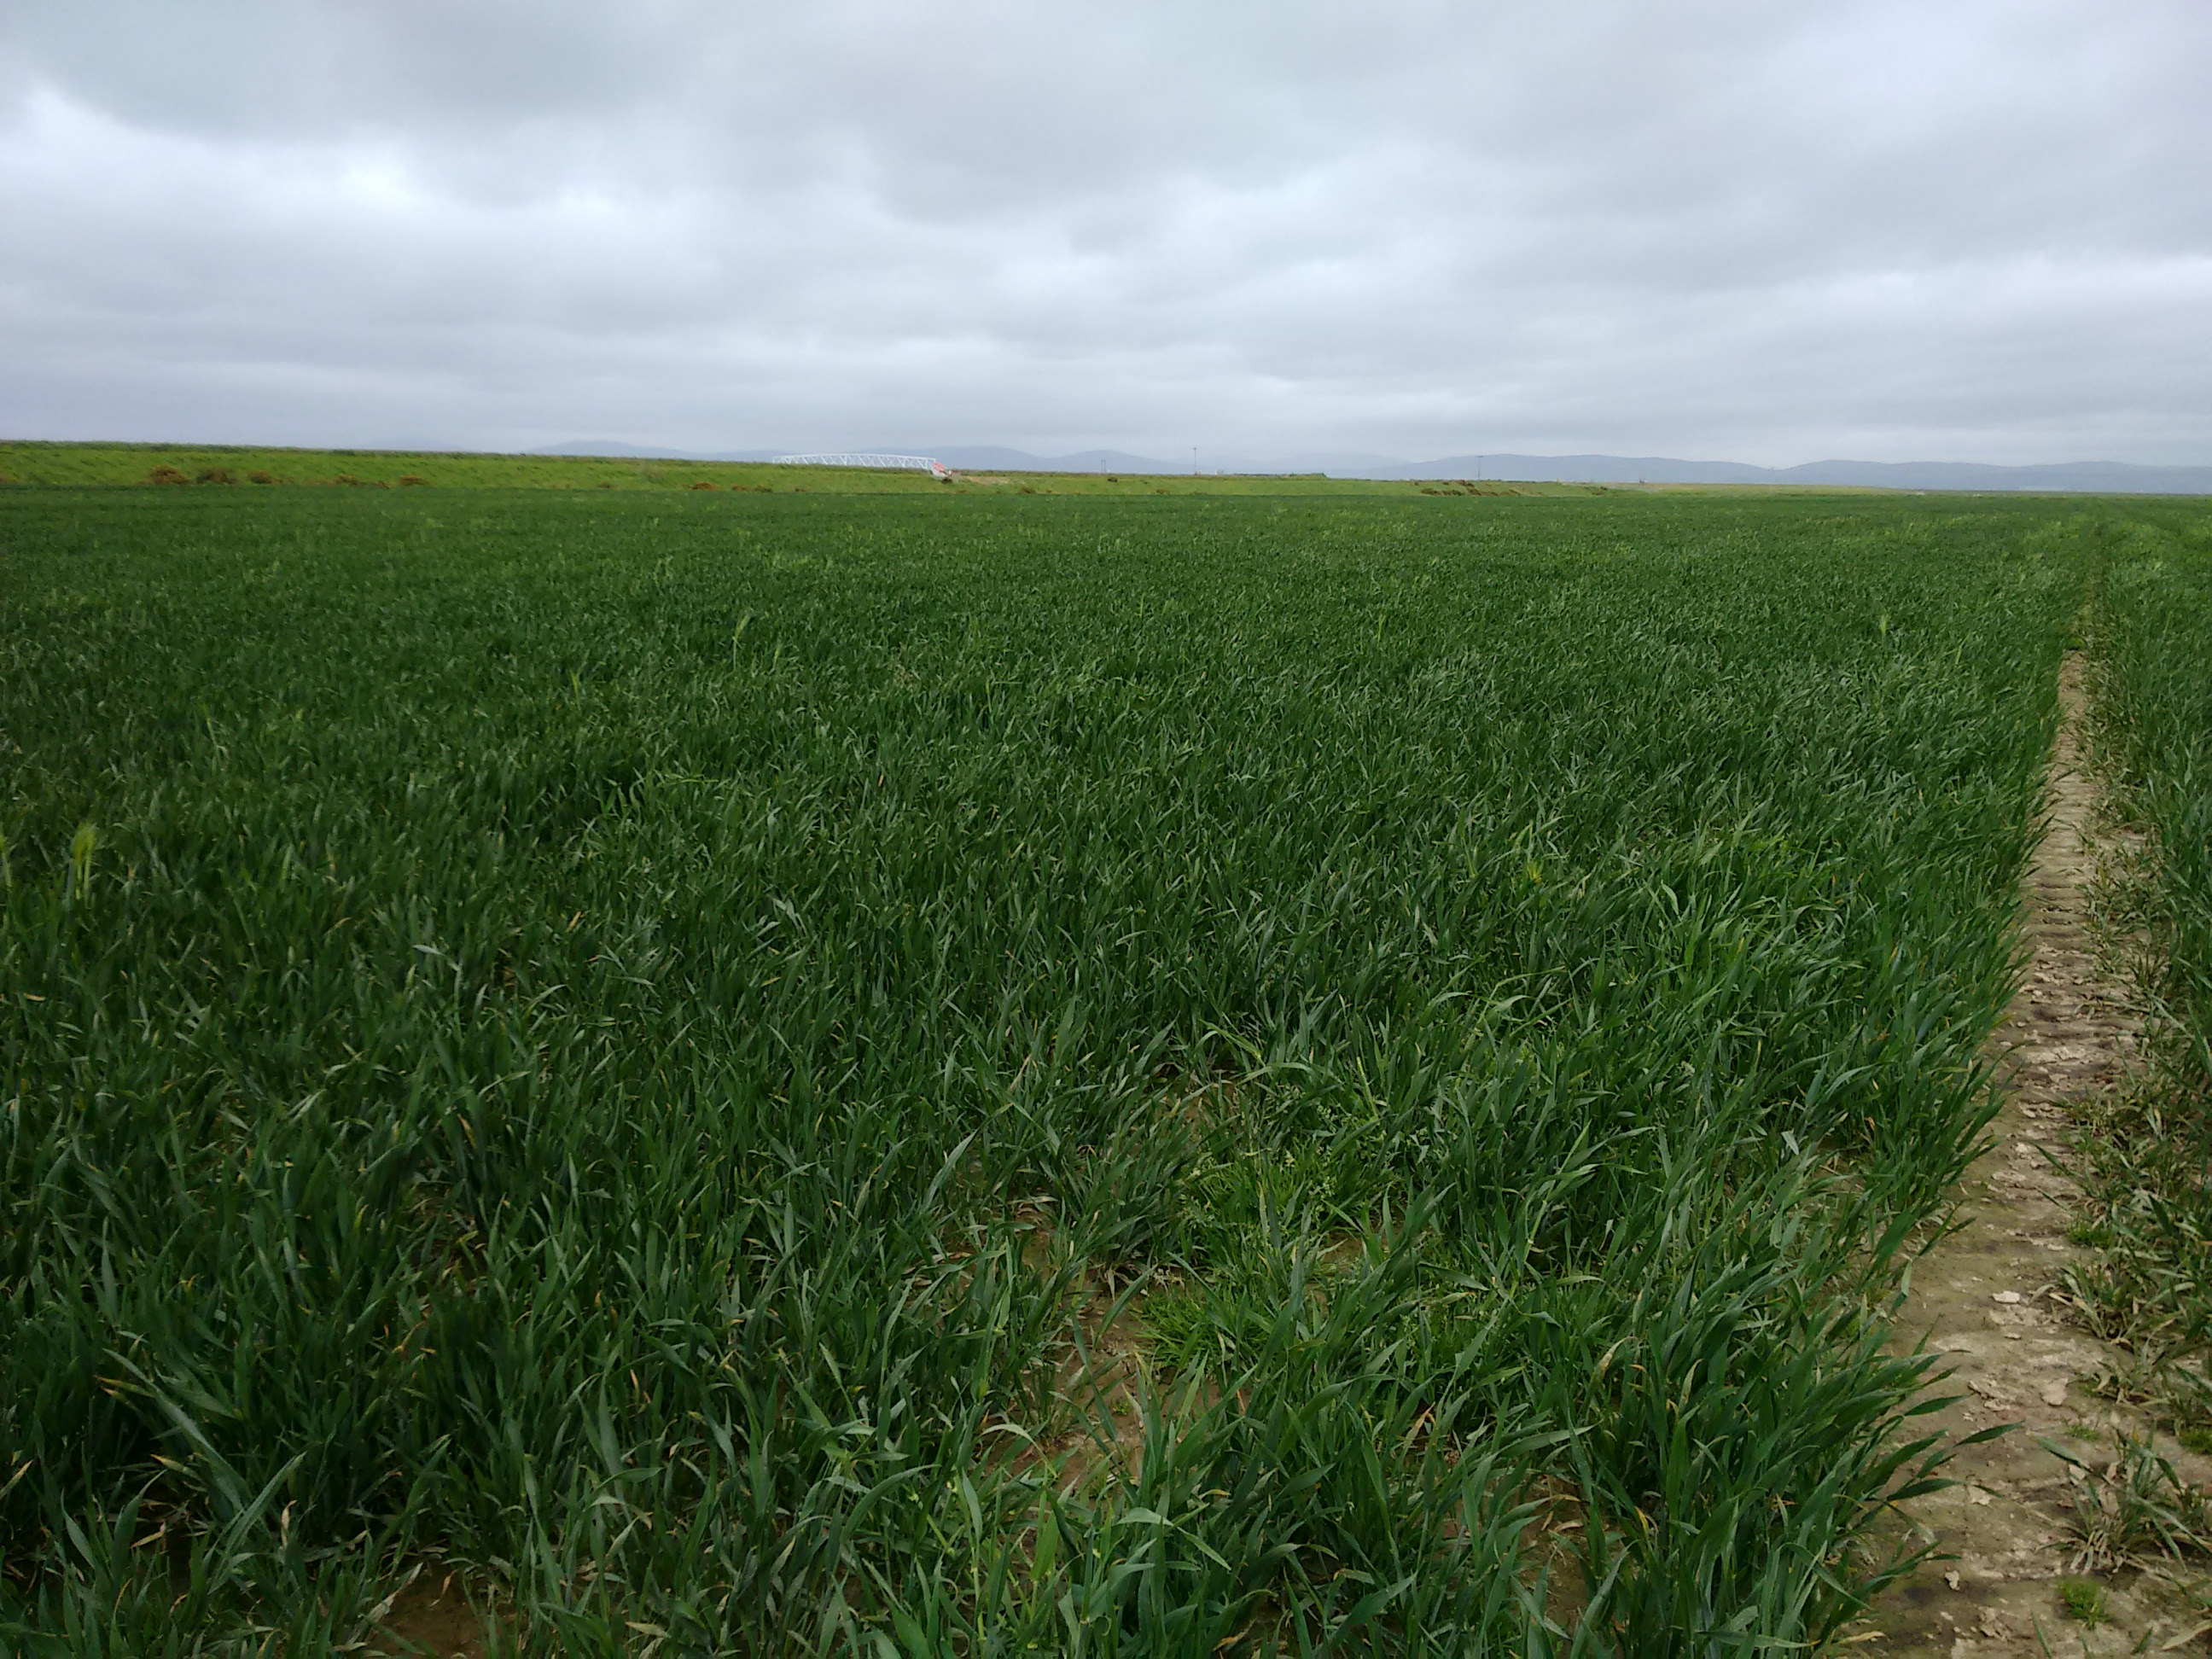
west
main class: Cropland
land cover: Common wheat
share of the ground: > 75 %
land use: Agriculture (excluding fallow land and kitchen gardens)
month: May
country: GB
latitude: 55.0764
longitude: -7.0066
